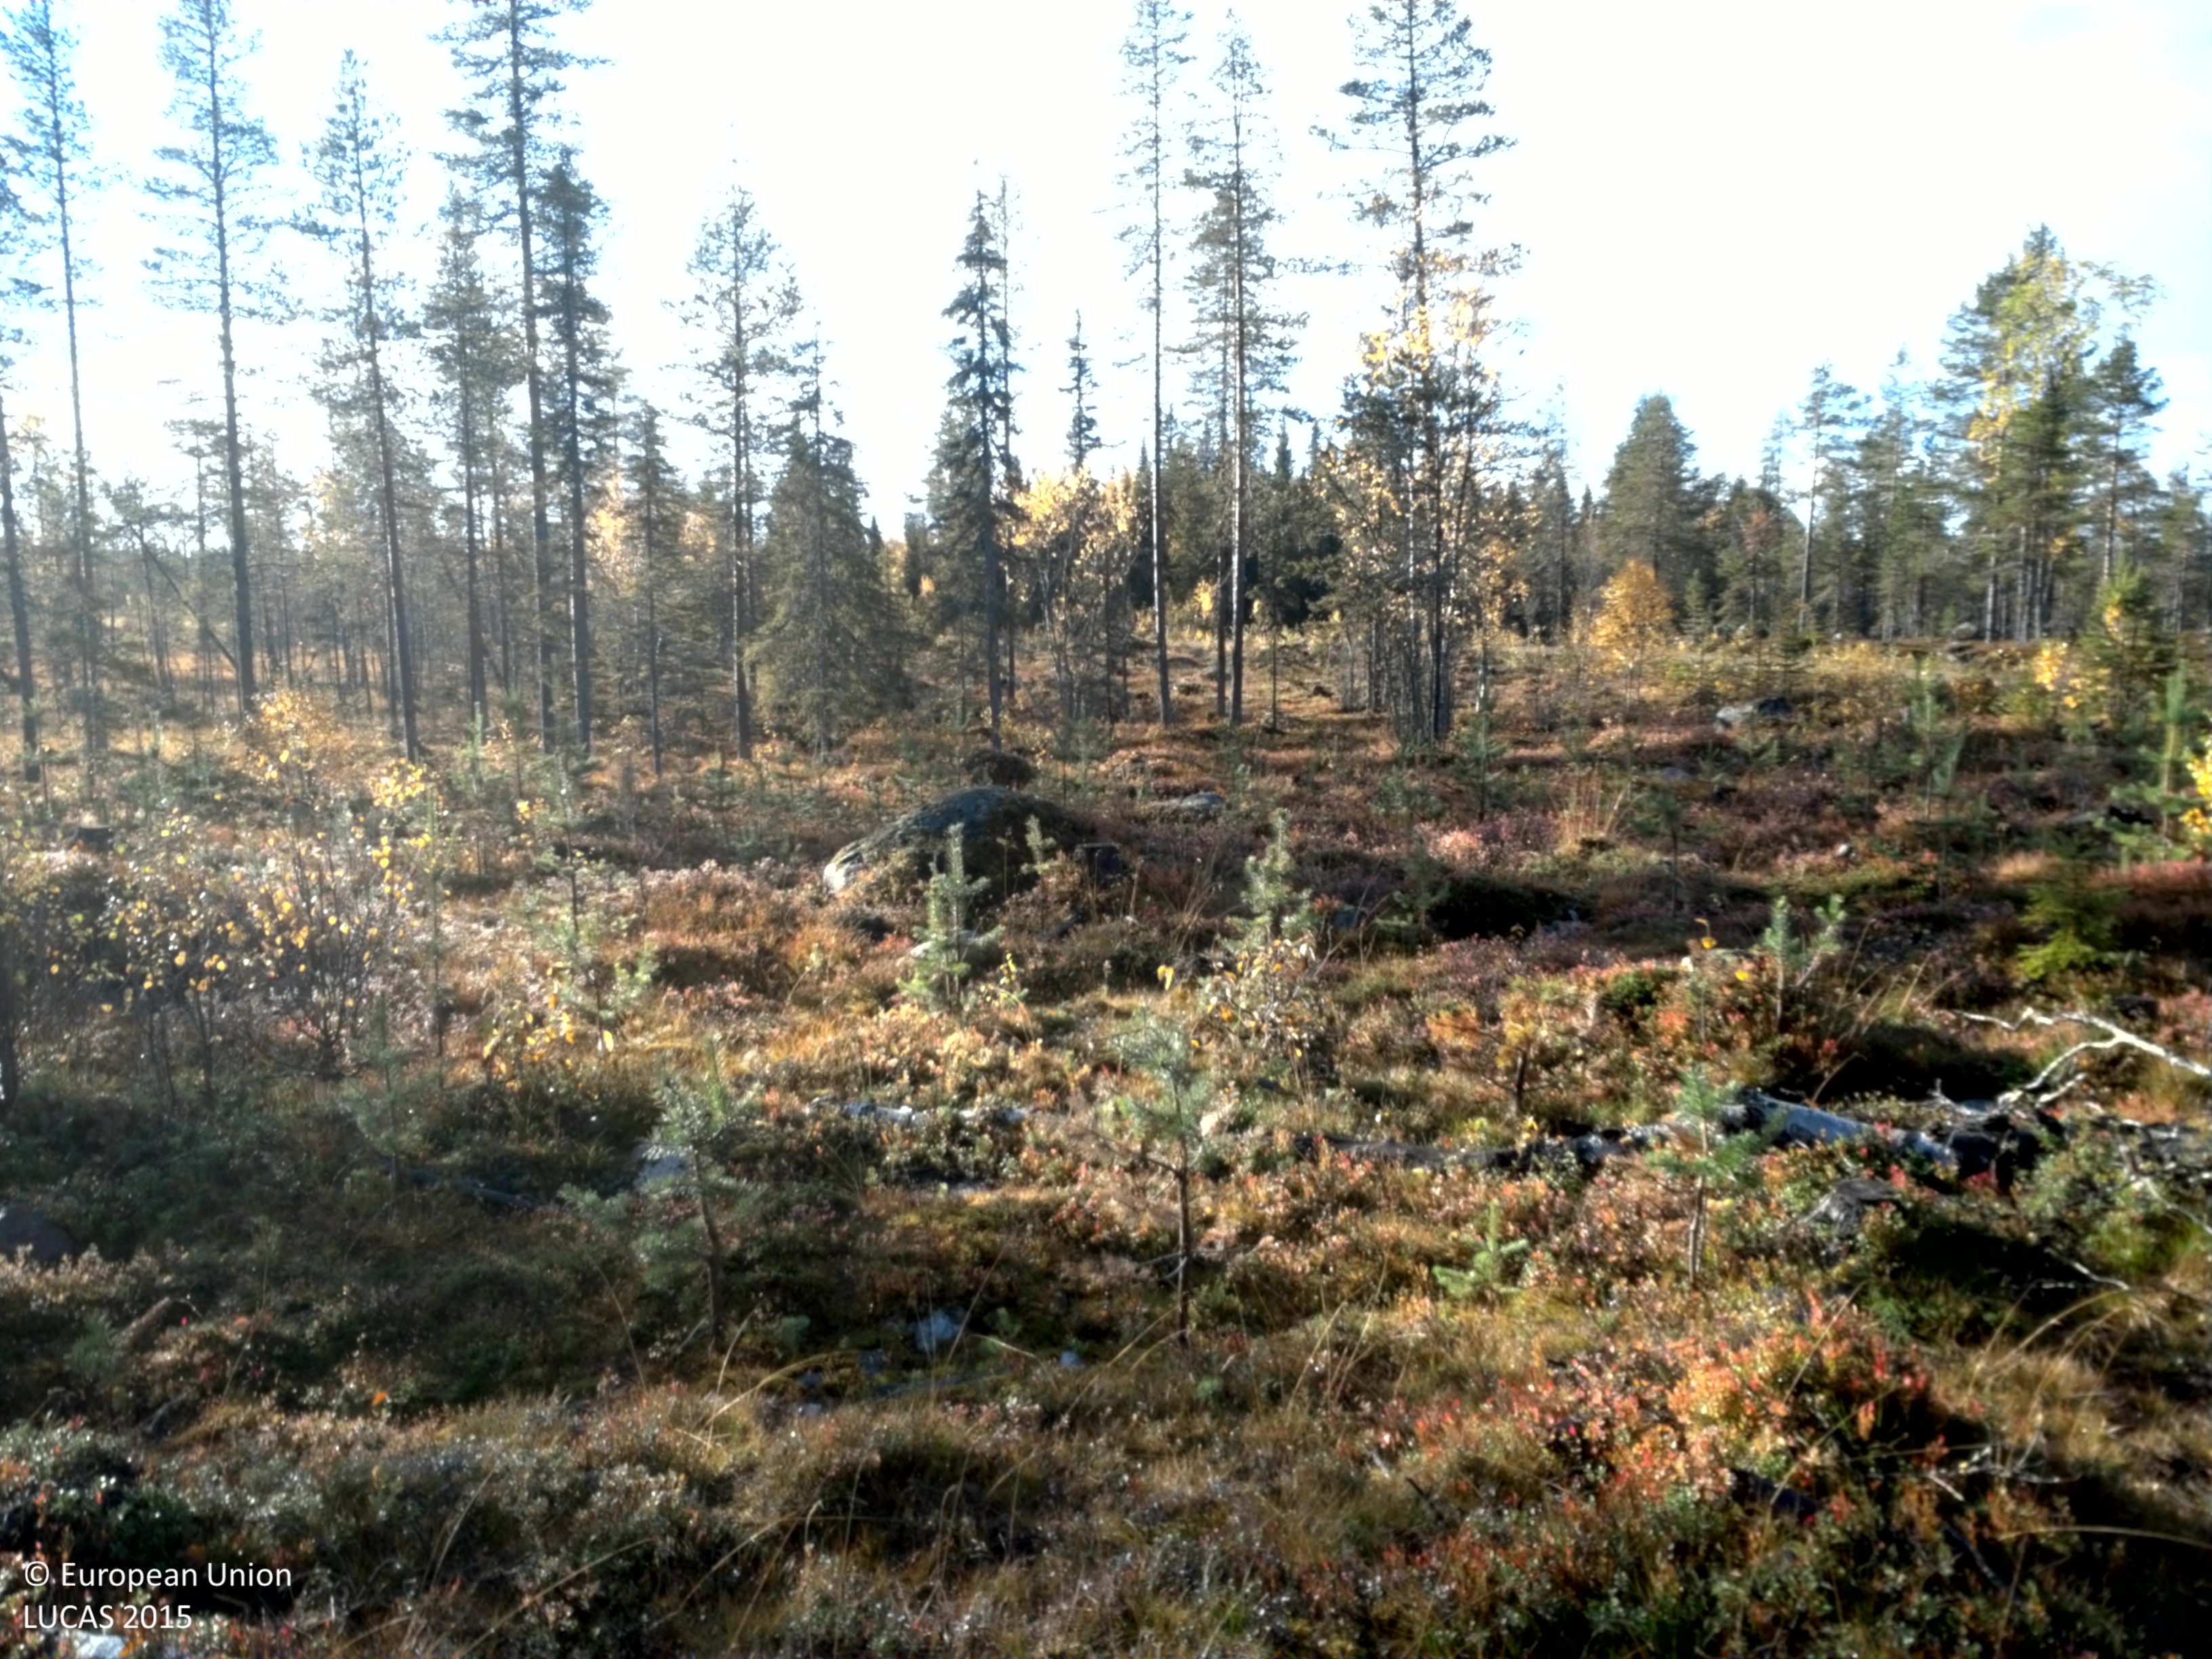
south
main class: Shrubland
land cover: Shrubland with sparse tree cover
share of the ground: 25 - 50 %
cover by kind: shrubs 40 %, herbaceous plants 35 %, lichens and mosses 15 %, coniferous forest trees 5 %, consolidated bare surface 5 %
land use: Forestry
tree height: < 5 m
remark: Clear cut
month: September
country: SE
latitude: 65.1414
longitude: 17.6161
